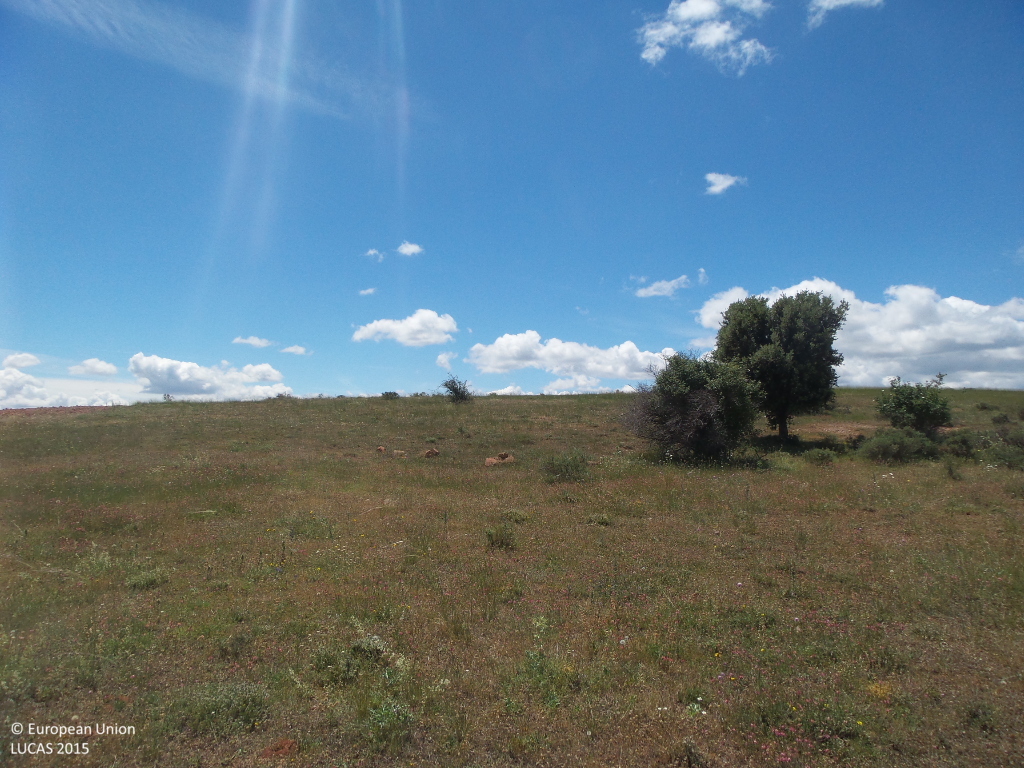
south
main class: Grassland
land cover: Spontaneously vegetated surfaces
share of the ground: > 75 %
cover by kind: herbaceous plants 95 %, shrubs 5 %
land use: Semi-natural and natural areas not in use
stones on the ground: < 10 %
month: June
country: ES
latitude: 41.2476
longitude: -2.9860
